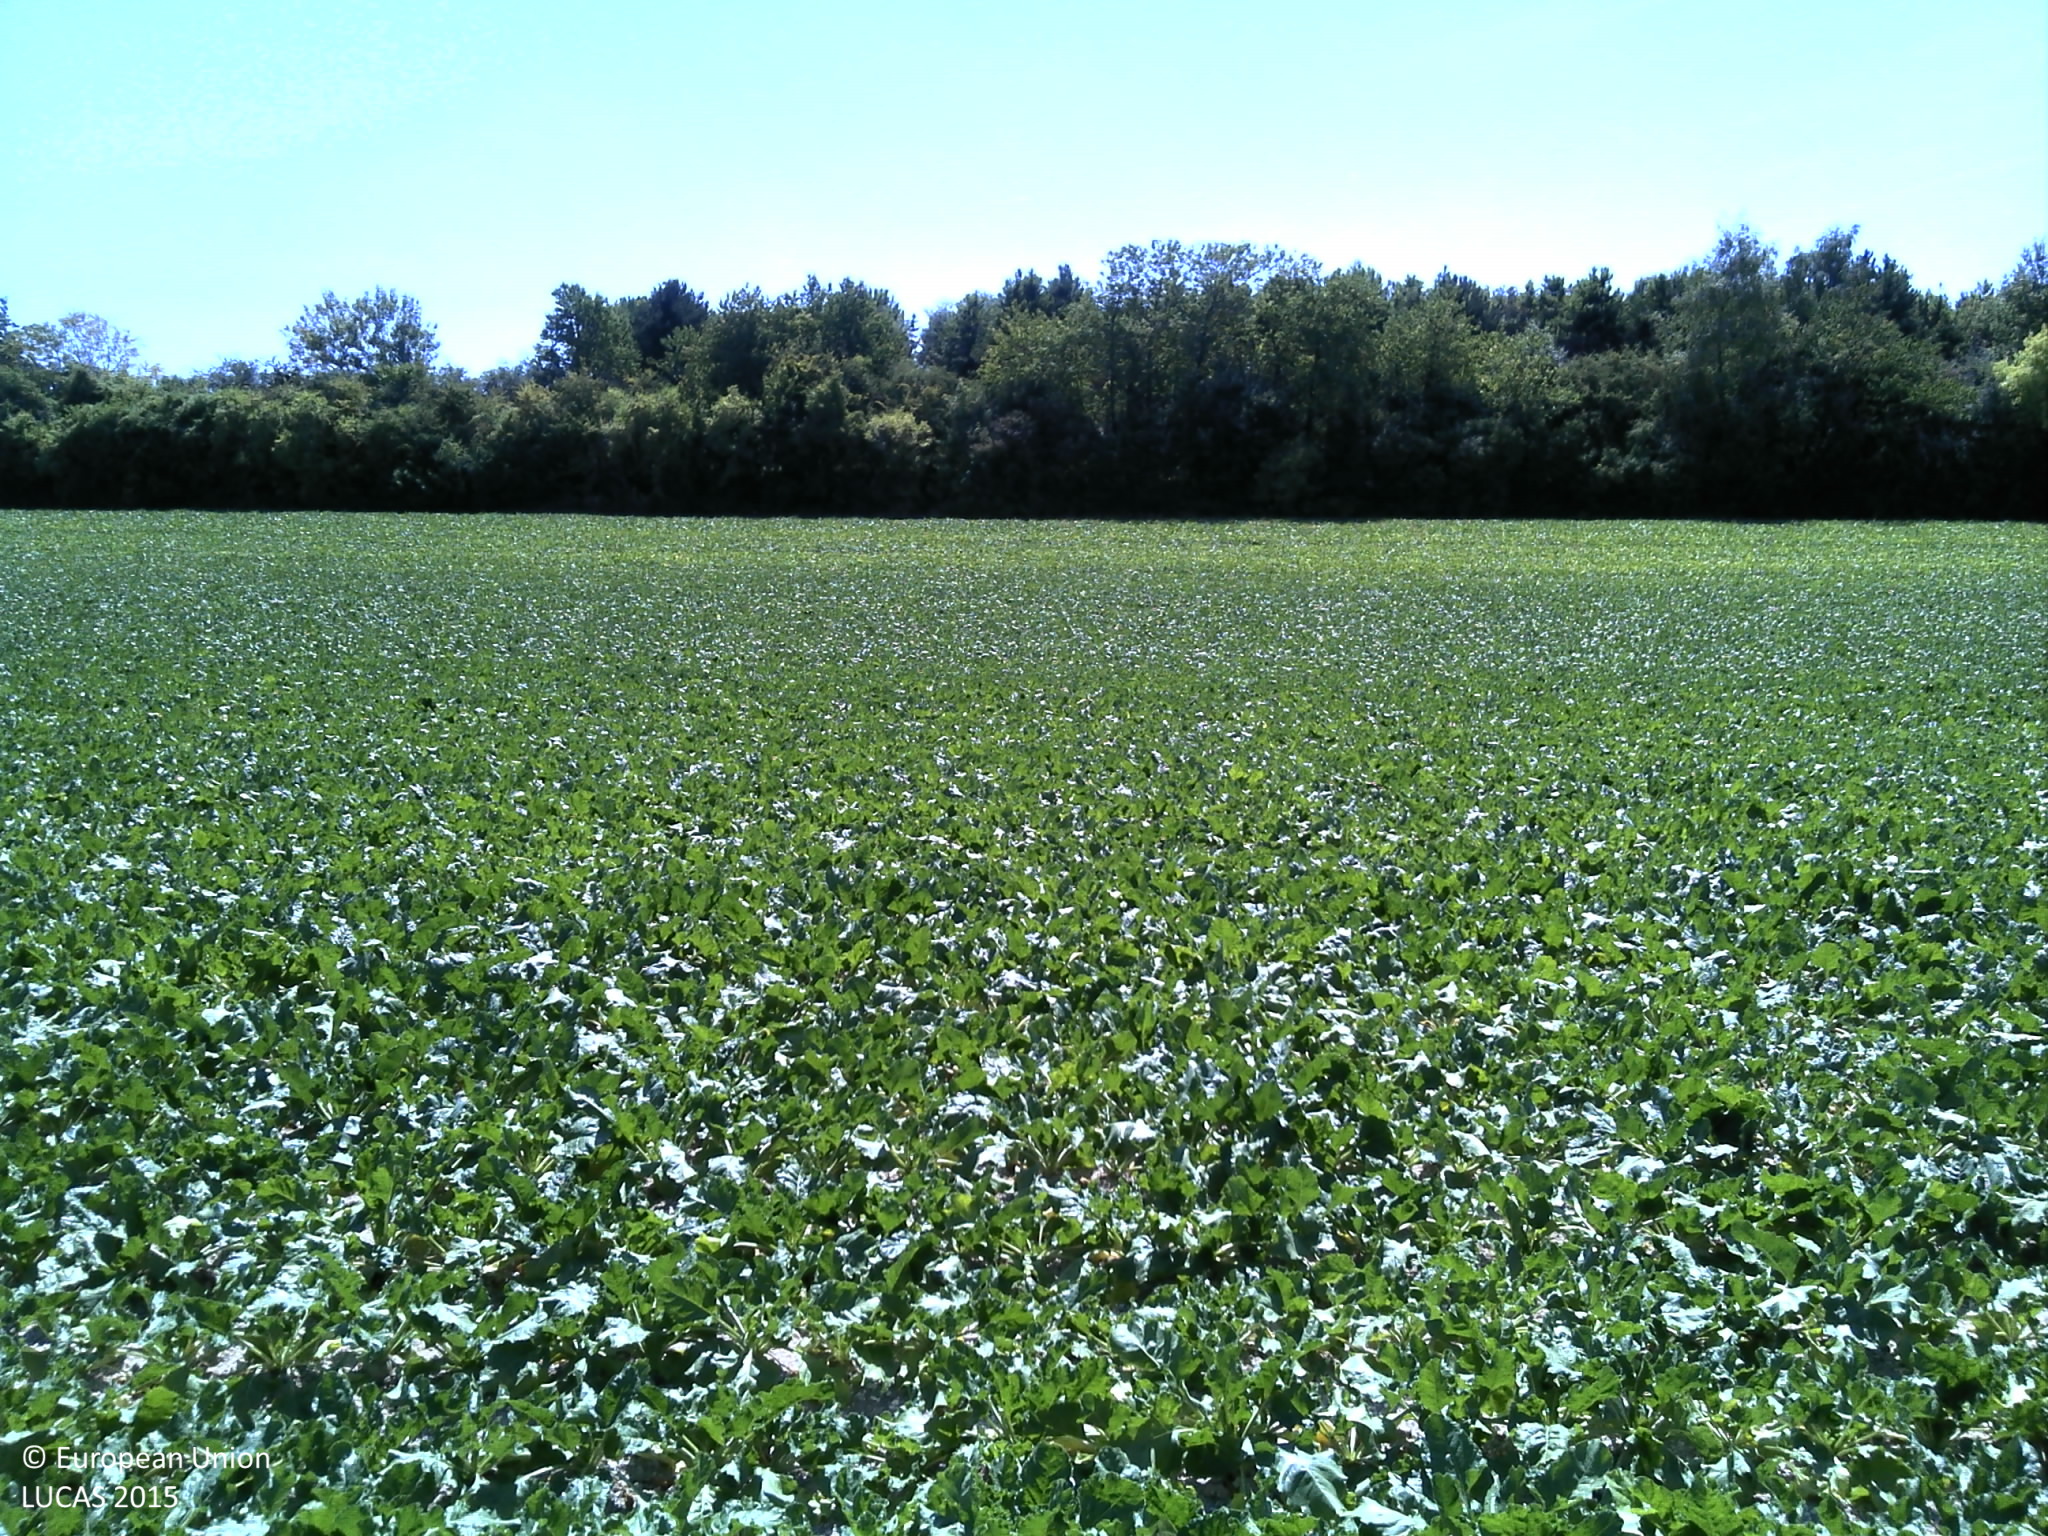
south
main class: Cropland
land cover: Sugar beet
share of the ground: > 75 %
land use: Agriculture (excluding fallow land and kitchen gardens)
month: August
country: FR
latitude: 48.9774
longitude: 4.6550
